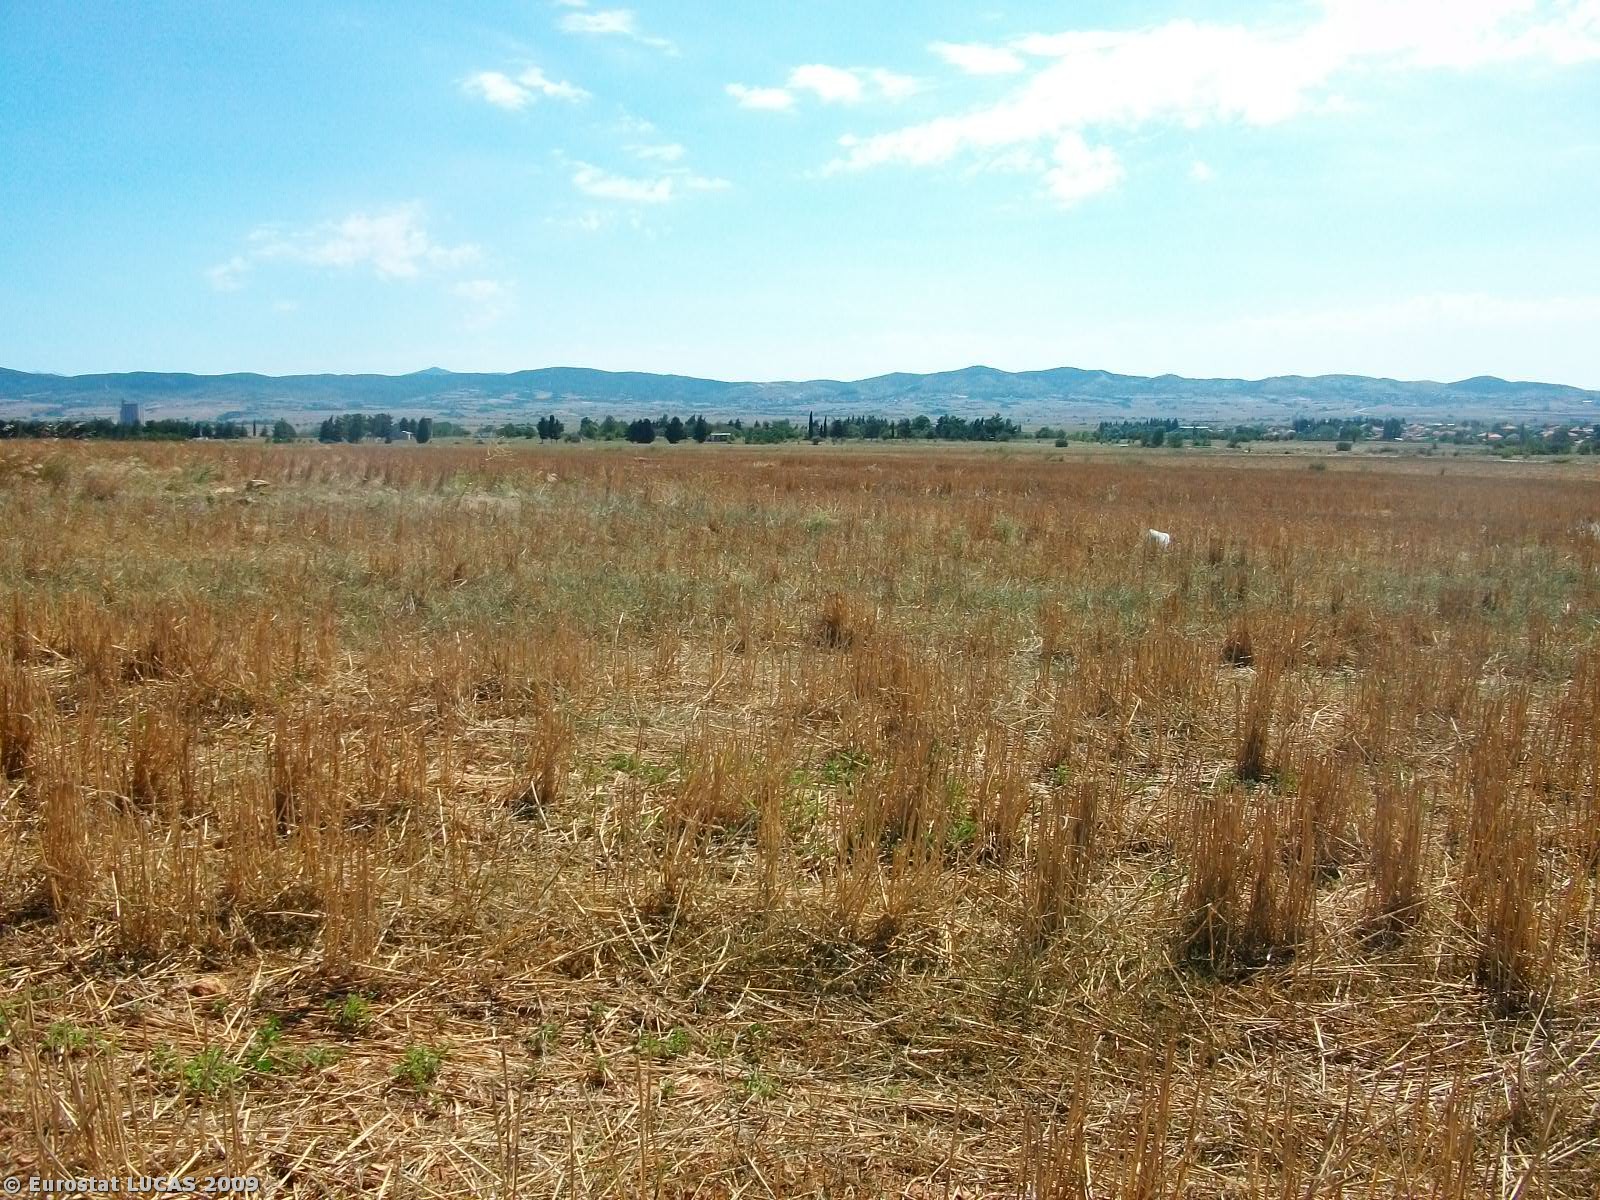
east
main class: Cropland
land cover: Barley
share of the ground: < 10 %
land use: Agriculture (excluding fallow land and kitchen gardens)
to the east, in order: Barley; Grass margins; Barley; Grass margins; Barley
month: July
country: GR
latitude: 41.0942
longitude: 22.7610
